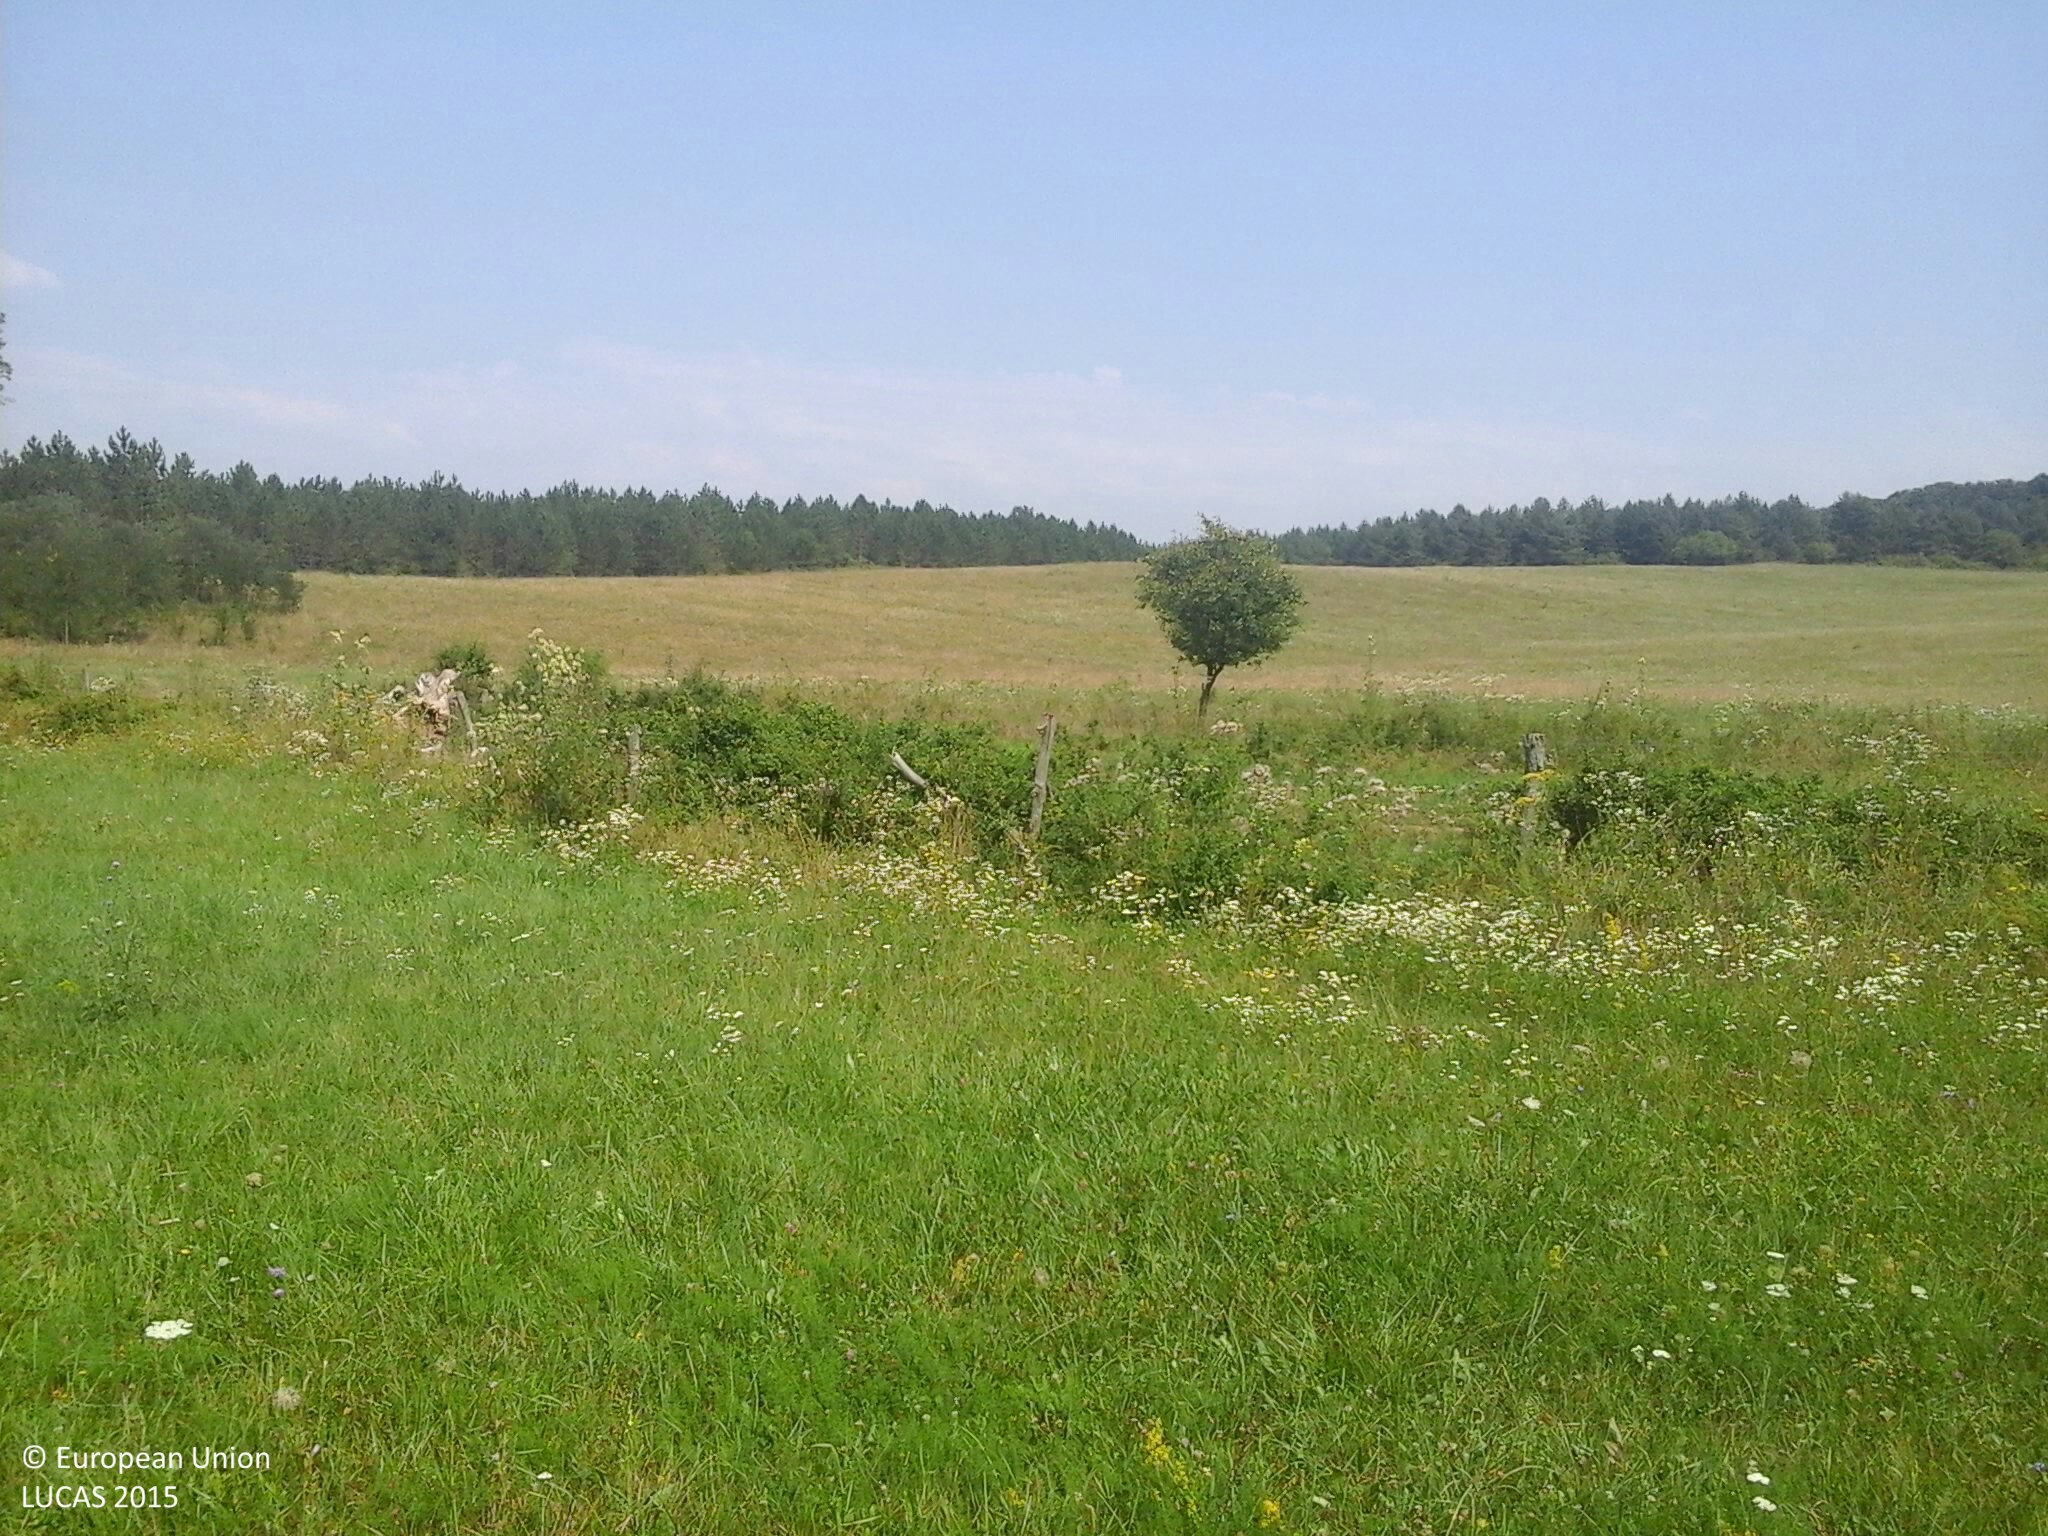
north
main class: Grassland
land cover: Grassland without tree/shrub cover
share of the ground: > 75 %
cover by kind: herbaceous plants 100 %
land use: Agriculture (excluding fallow land and kitchen gardens)
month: August
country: HU
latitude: 48.4878
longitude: 20.8223
